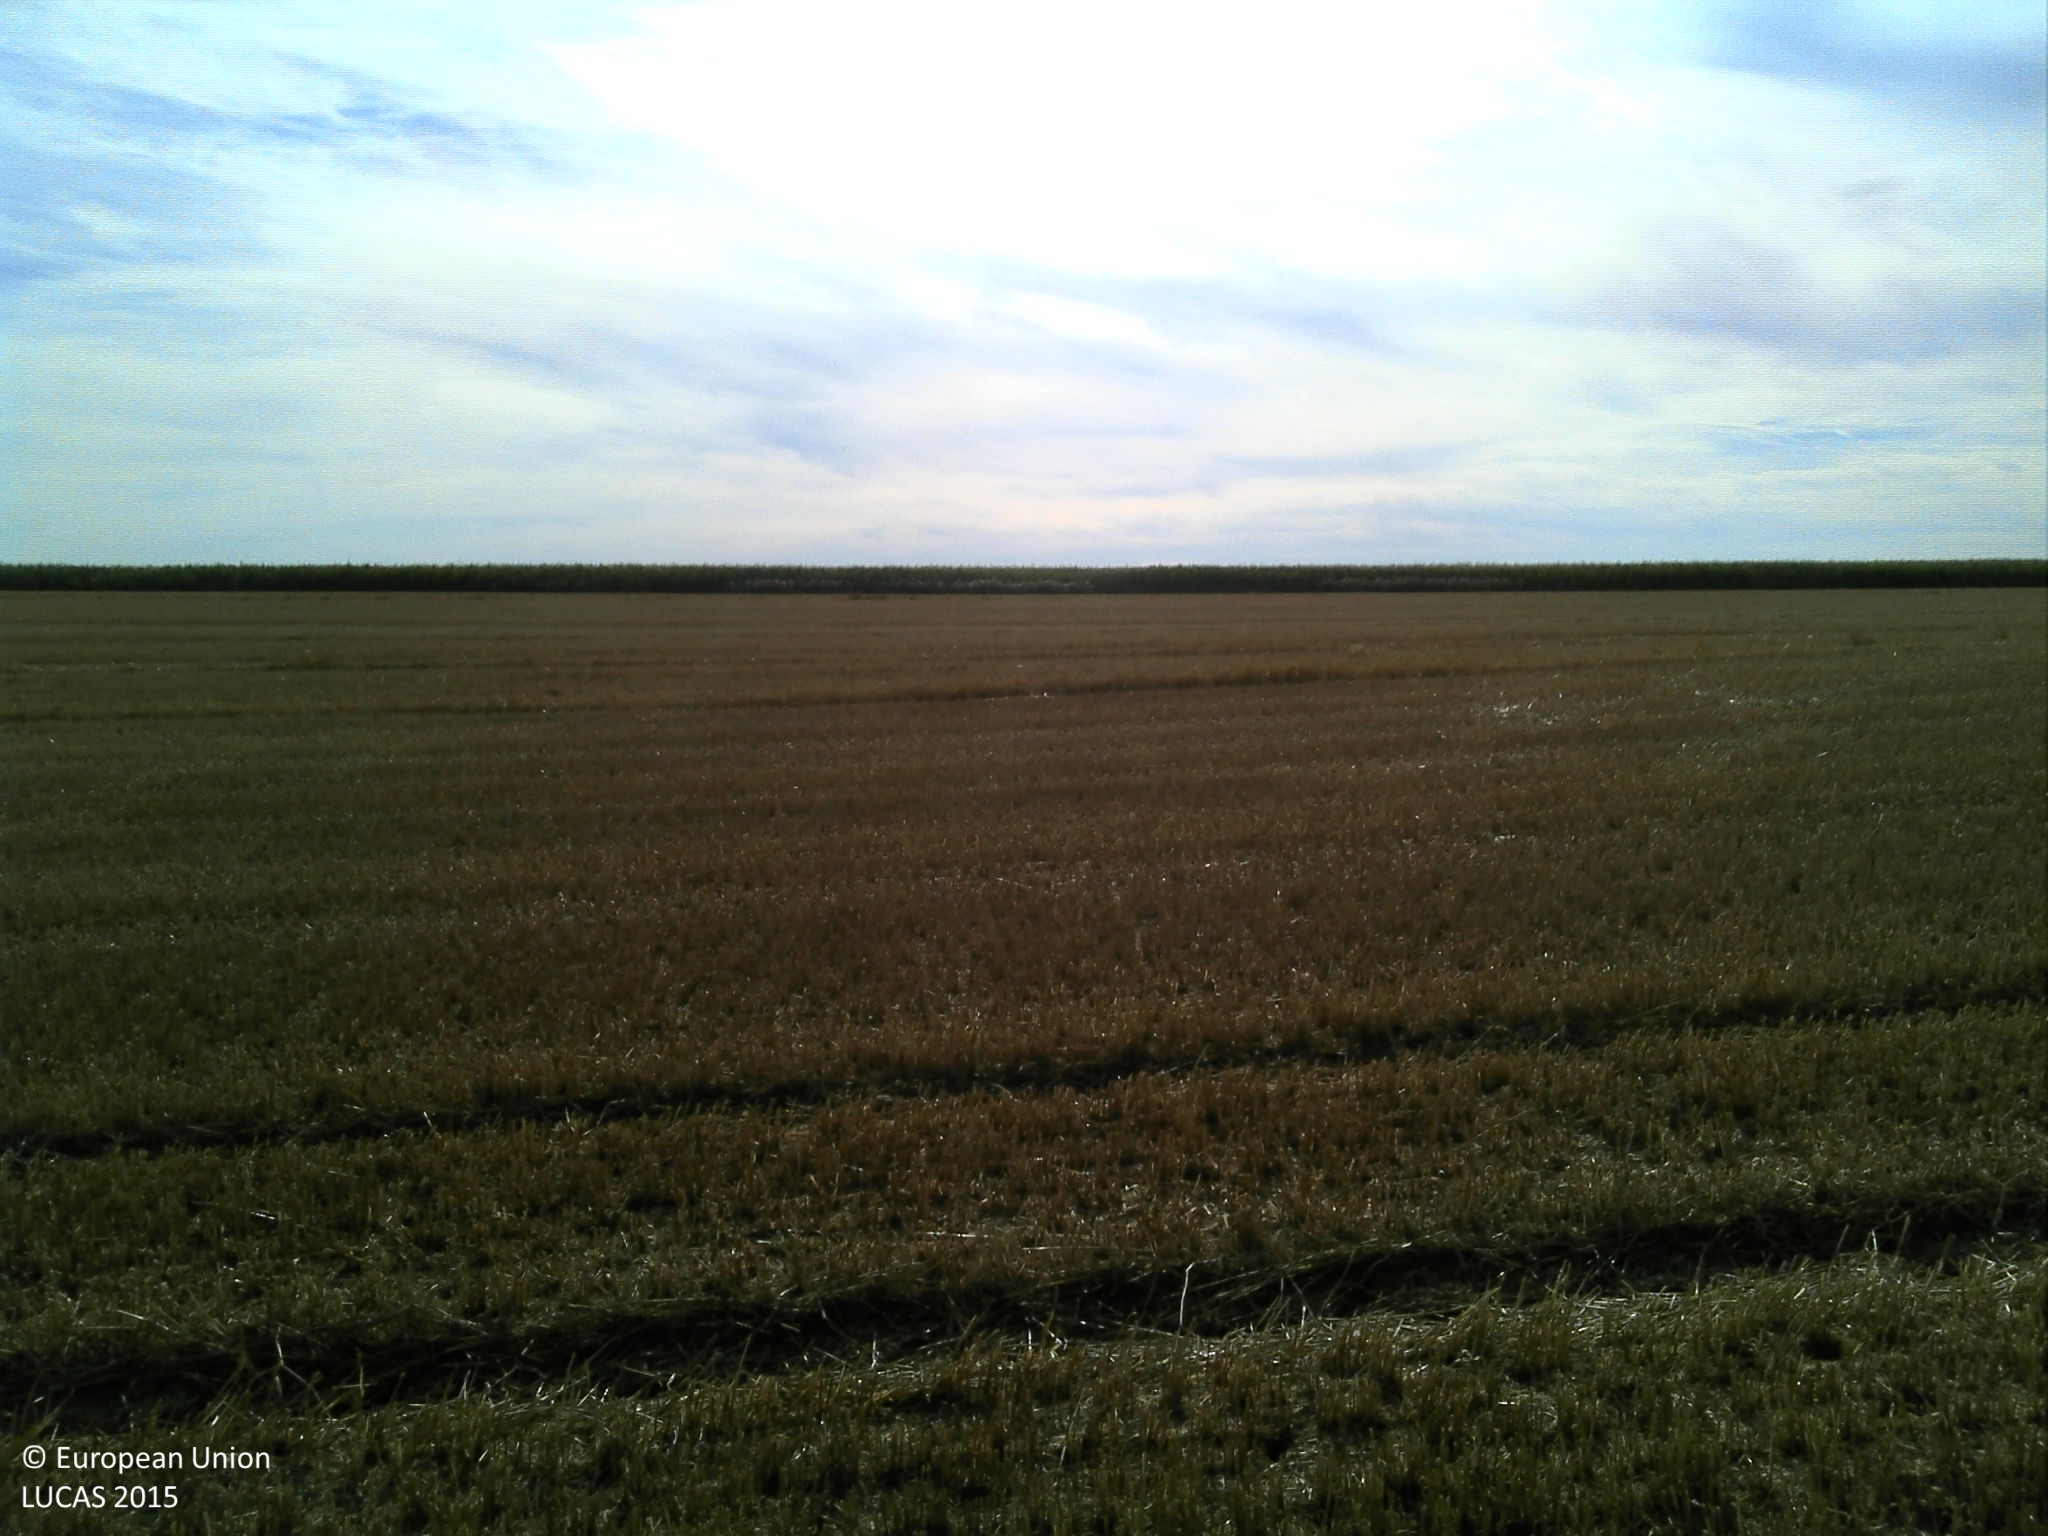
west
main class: Cropland
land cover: Common wheat
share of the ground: > 75 %
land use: Agriculture (excluding fallow land and kitchen gardens)
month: August
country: FR
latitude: 48.9493
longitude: 4.8223
